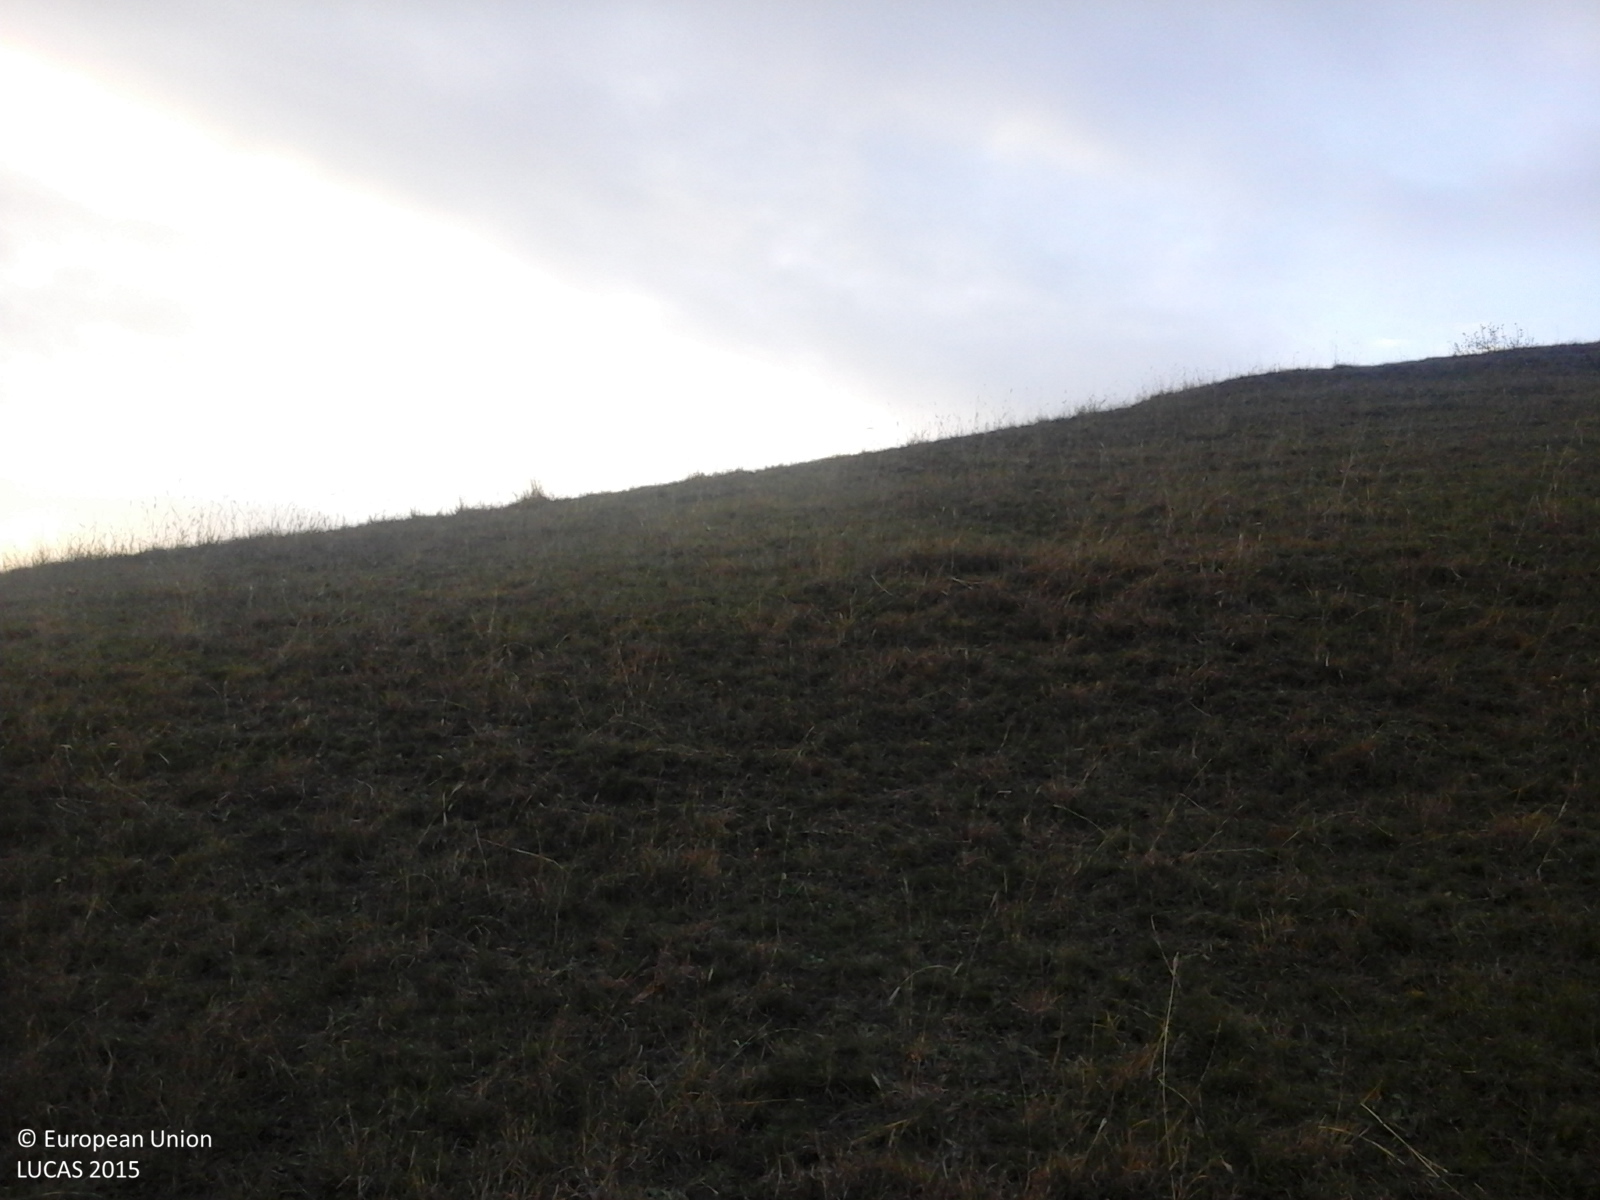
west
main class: Grassland
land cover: Grassland with sparse tree/shrub cover
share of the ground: > 75 %
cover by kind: herbaceous plants 95 %, broadleaved forest trees 5 %
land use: Agriculture (excluding fallow land and kitchen gardens)
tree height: > 5 m
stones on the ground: < 10 %
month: October
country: RO
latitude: 45.4779
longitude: 26.7496
